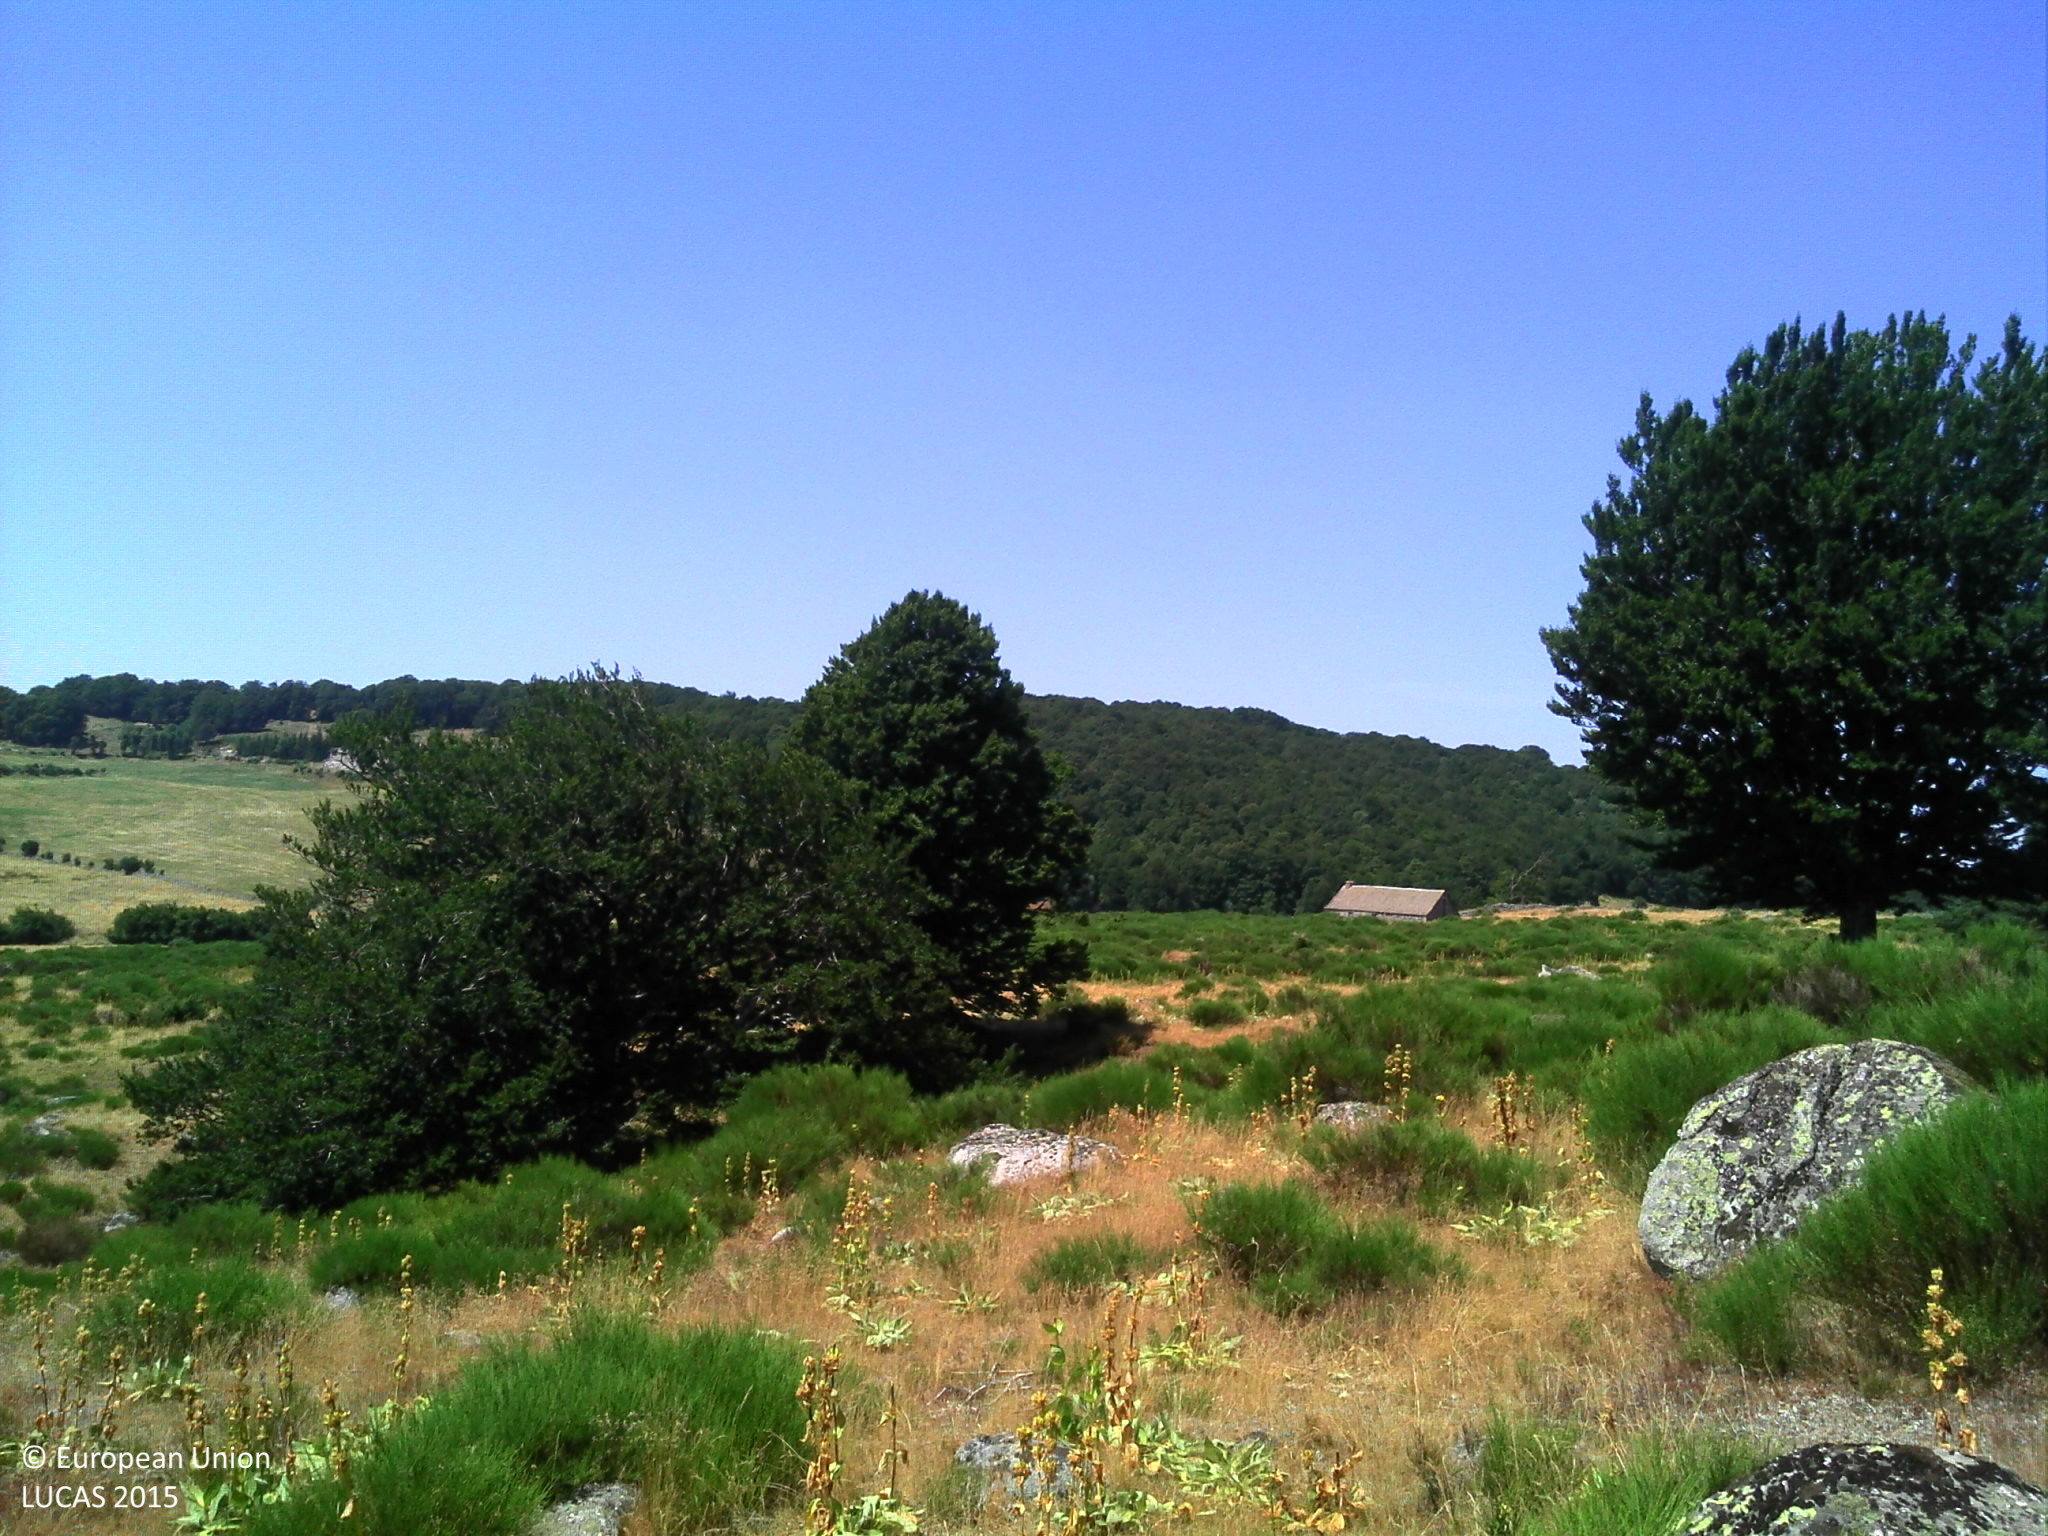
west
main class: Shrubland
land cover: Shrubland without tree cover
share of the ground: > 75 %
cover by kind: shrubs 90 %, herbaceous plants 10 %
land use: Agriculture (excluding fallow land and kitchen gardens)
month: July
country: FR
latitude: 44.6330
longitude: 3.1844
